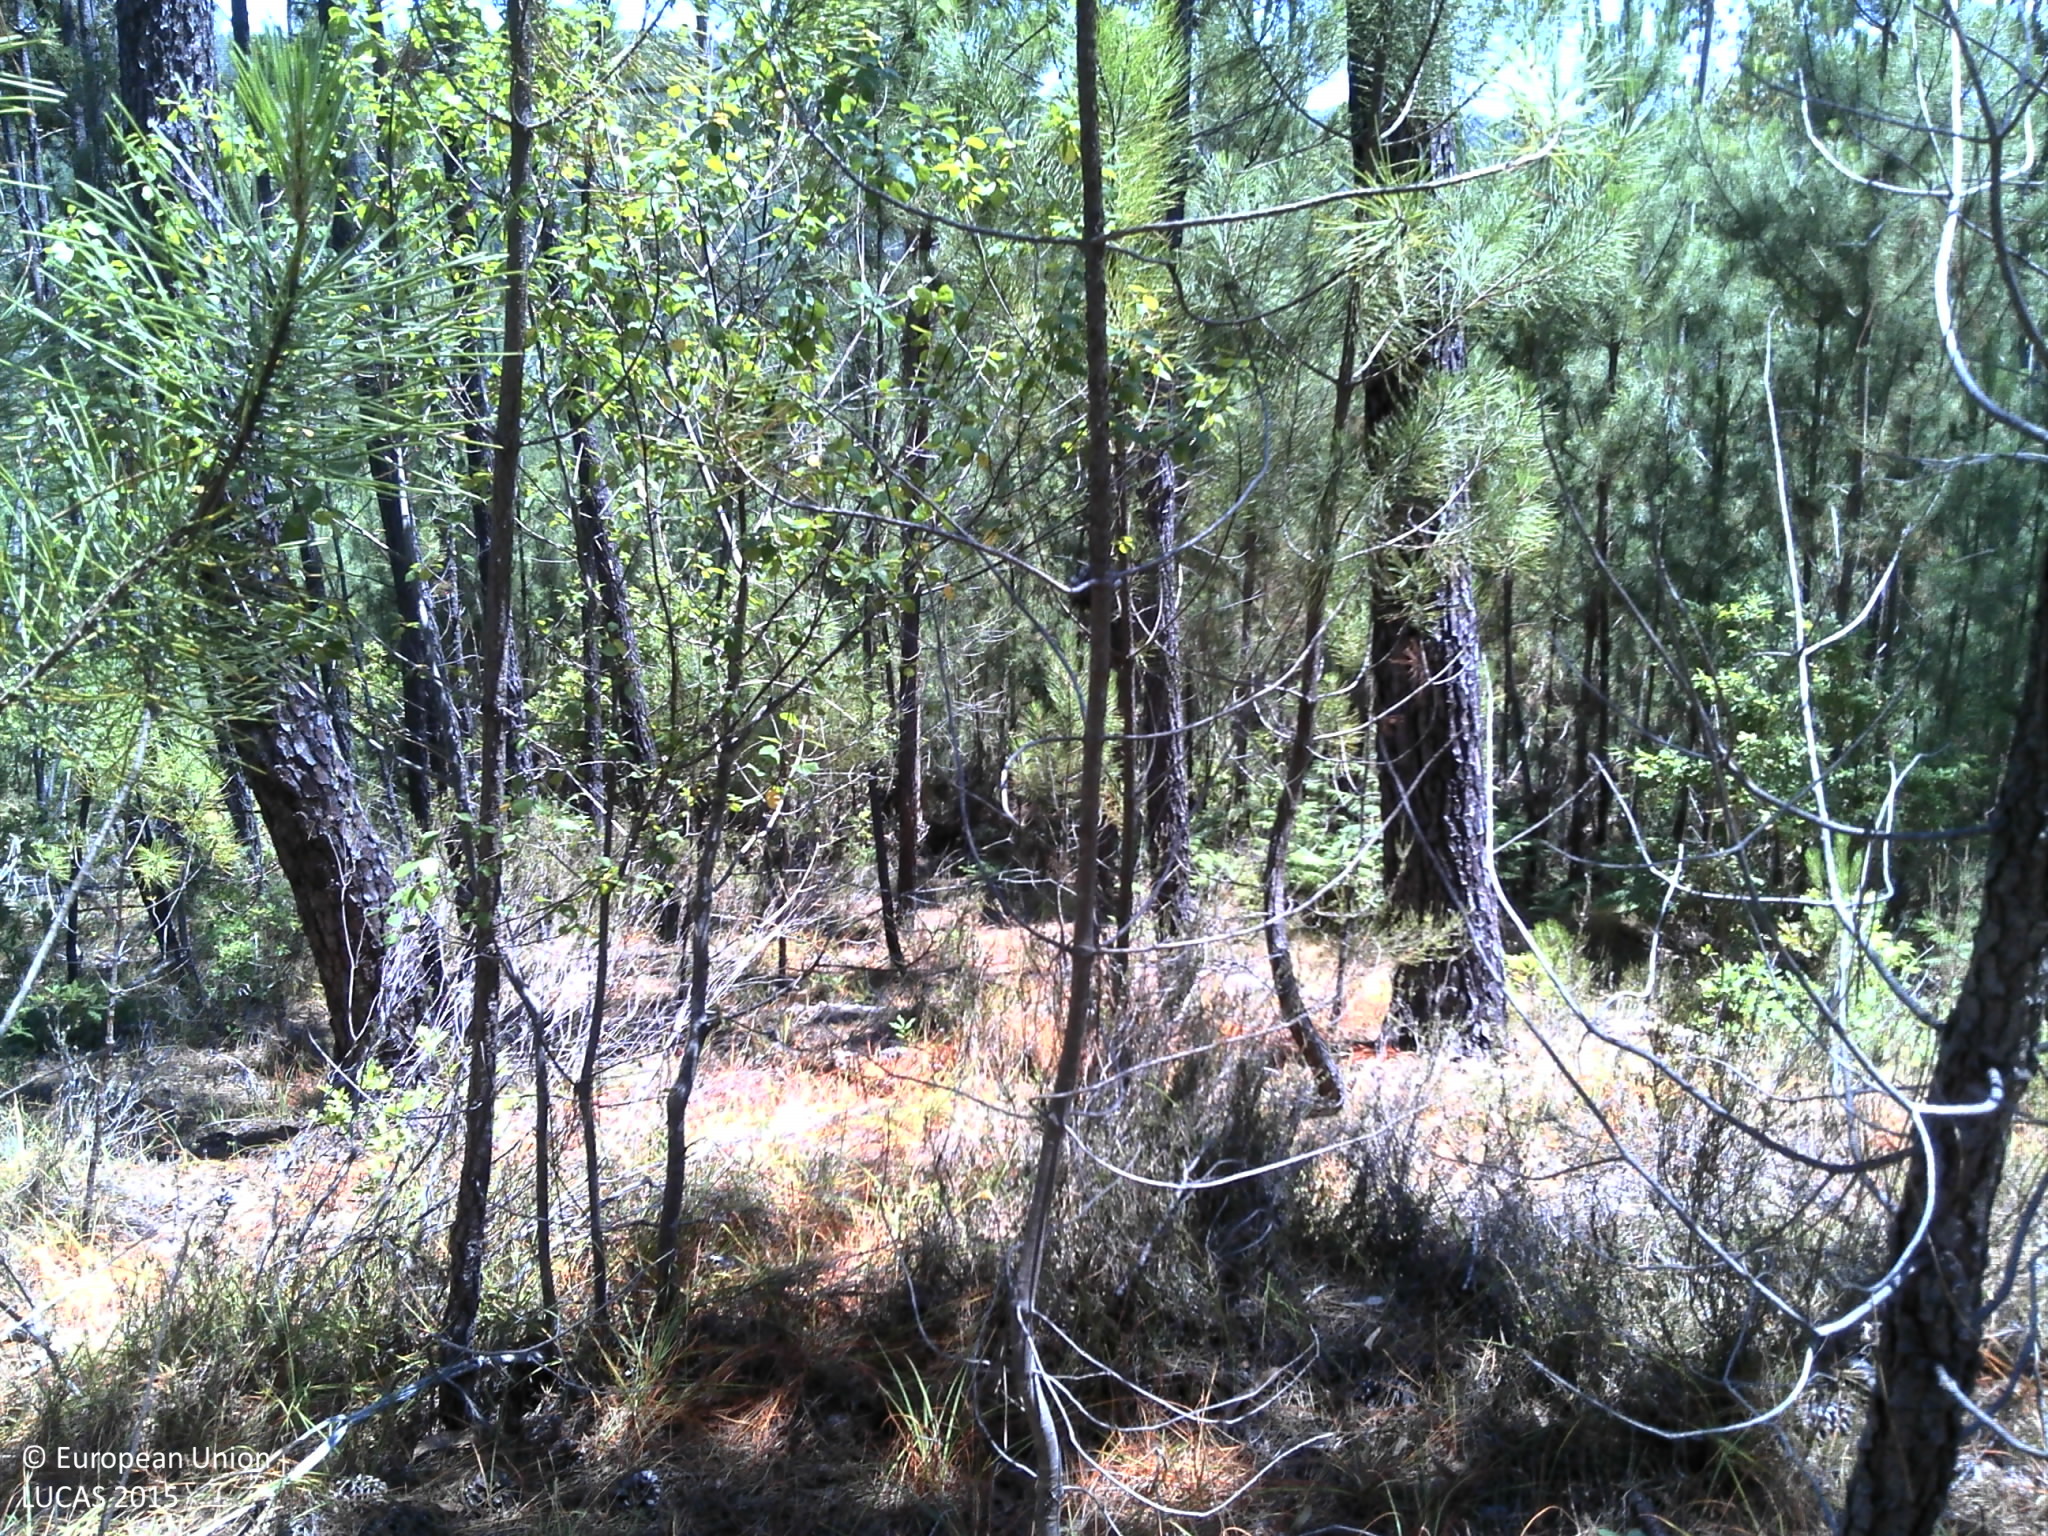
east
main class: Woodland
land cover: Pine dominated mixed woodland
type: coniferous forest of the mediterranean region
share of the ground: 10 - 25 %
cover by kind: shrubs 40 %, unconsolidated bare surface 30 %, coniferous forest trees 15 %, herbaceous plants 10 %, broadleaved forest trees 5 %
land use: Forestry
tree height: > 5 m
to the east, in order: Pine dominated mixed woodland; Tracks; Pine dominated coniferous woodland; Rivers and streams; Shrubland with sparse tree cover; Rivers and streams; Broadleaved woodland
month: July
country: PT
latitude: 39.9530
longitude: -8.2043
